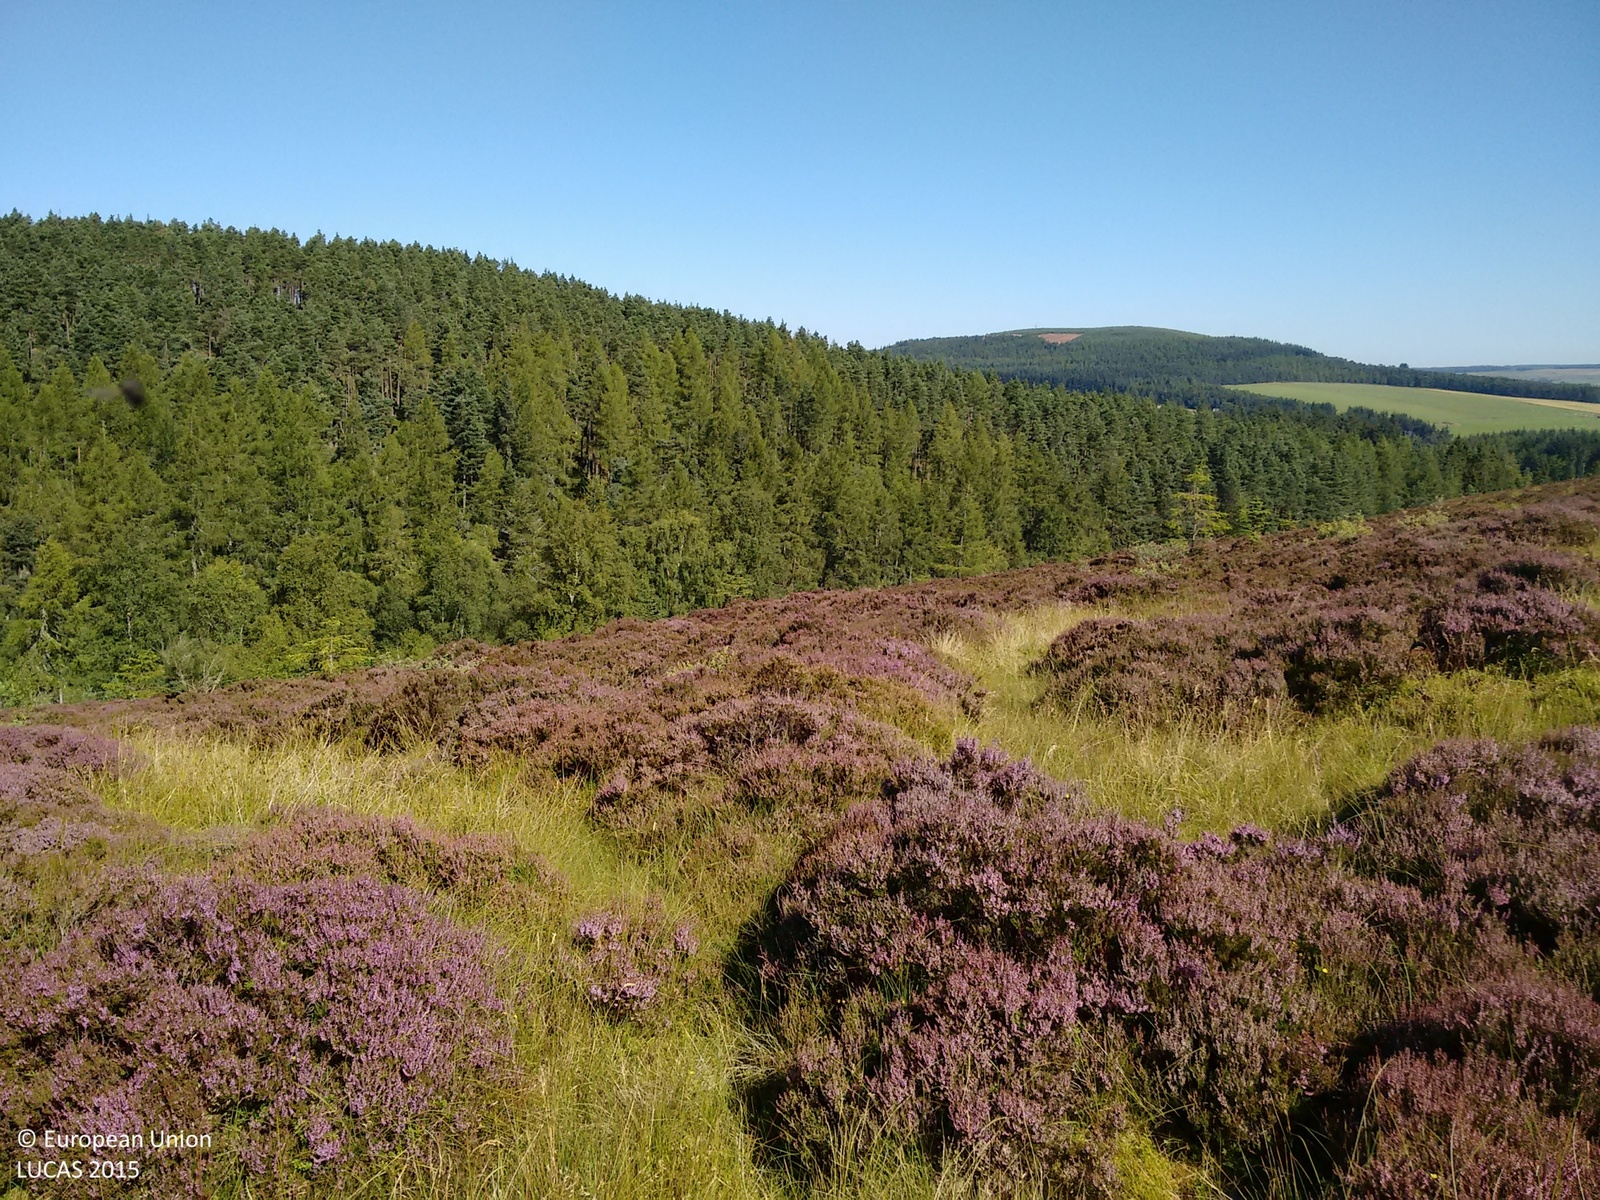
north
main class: Shrubland
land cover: Shrubland without tree cover
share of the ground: > 75 %
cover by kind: shrubs 55 %, herbaceous plants 45 %
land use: Agriculture (excluding fallow land and kitchen gardens)
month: August
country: GB
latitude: 57.5261
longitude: -3.0369
